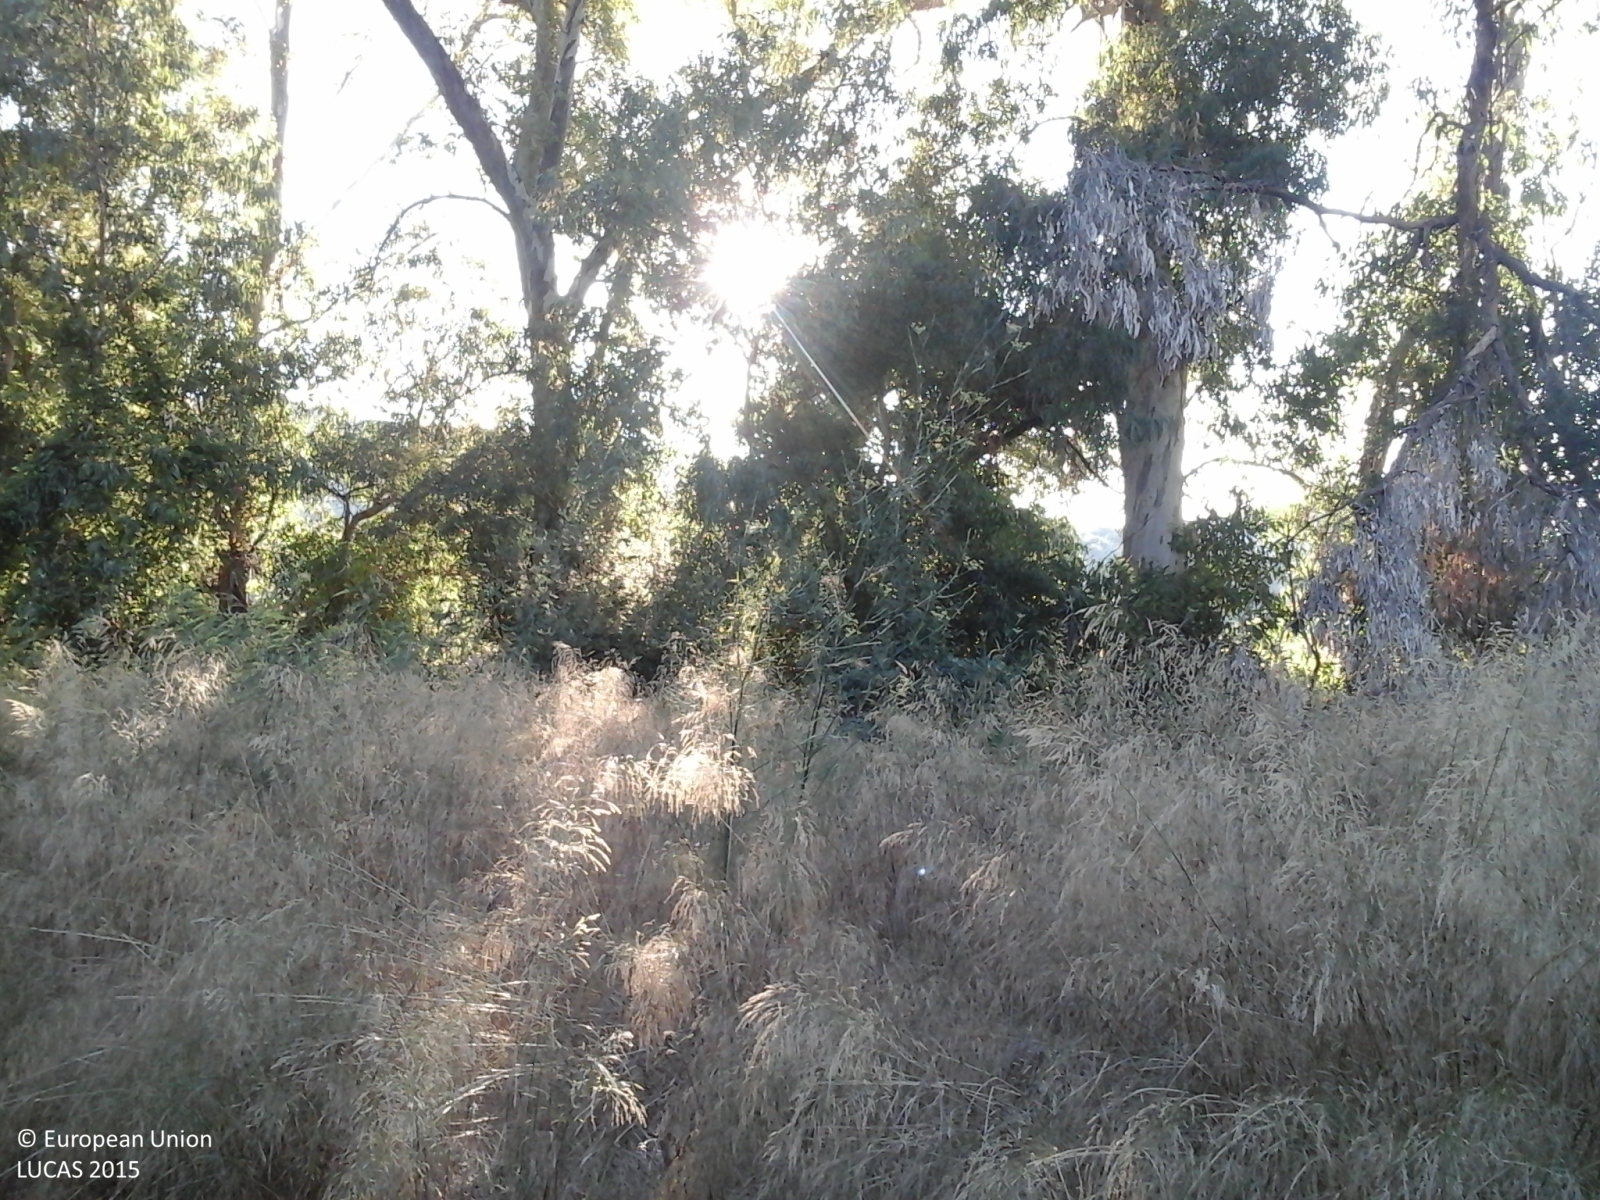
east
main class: Woodland
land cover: Pine dominated mixed woodland
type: broadleaved evergreen forest
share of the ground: > 75 %
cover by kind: coniferous forest trees 75 %, broadleaved forest trees 25 %
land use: Forestry
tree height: > 5 m
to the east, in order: Pine dominated mixed woodland; Tracks; Grassland without tree/shrub cover; Grass margins; Ditches and canals; Grass margins; Tracks; Shrubland with sparse tree cover
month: August
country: IT
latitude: 42.7770
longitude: 10.8406
